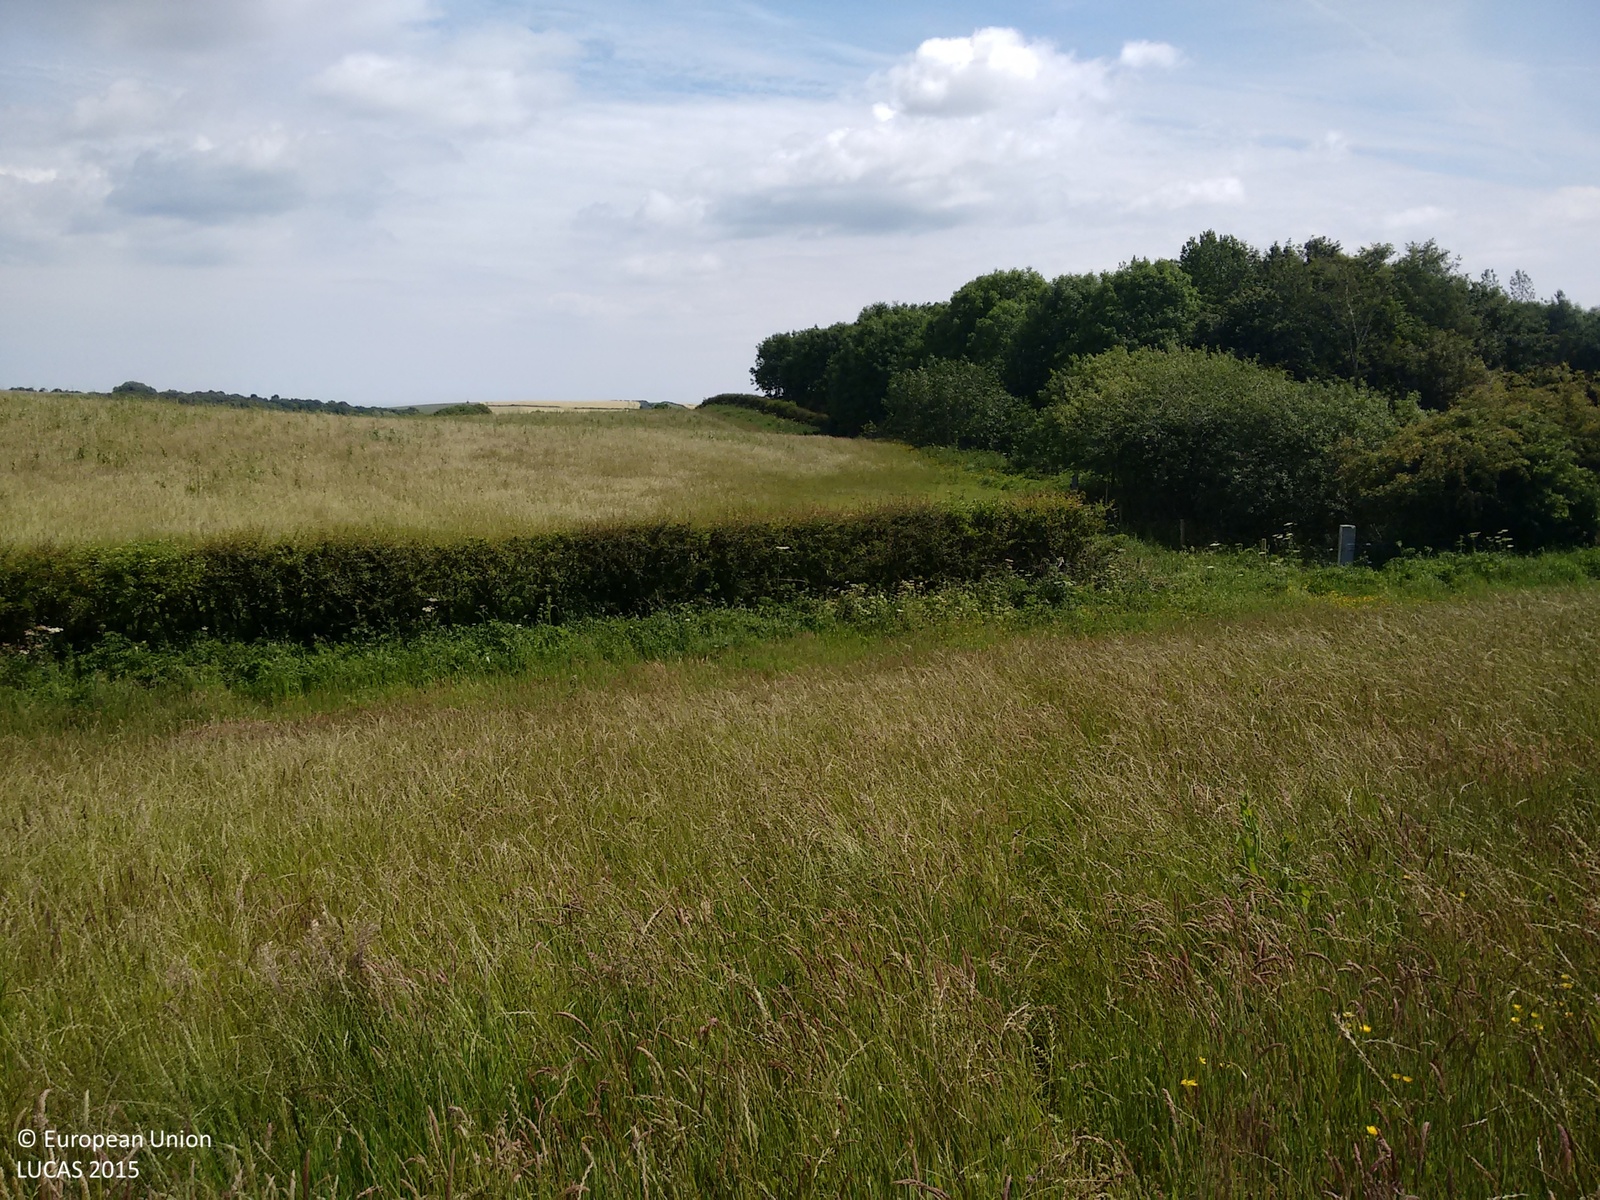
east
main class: Grassland
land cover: Grassland without tree/shrub cover
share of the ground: > 75 %
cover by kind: herbaceous plants 100 %
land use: Agriculture (excluding fallow land and kitchen gardens)
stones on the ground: < 10 %
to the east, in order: Grassland without tree/shrub cover; Managed hedges; Grassland without tree/shrub cover; Managed hedges; Fences; Broadleaved woodland; Tracks; Broadleaved woodland; Fences; Grassland without tree/shrub cover
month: June
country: GB
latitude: 54.3246
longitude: -0.4757
